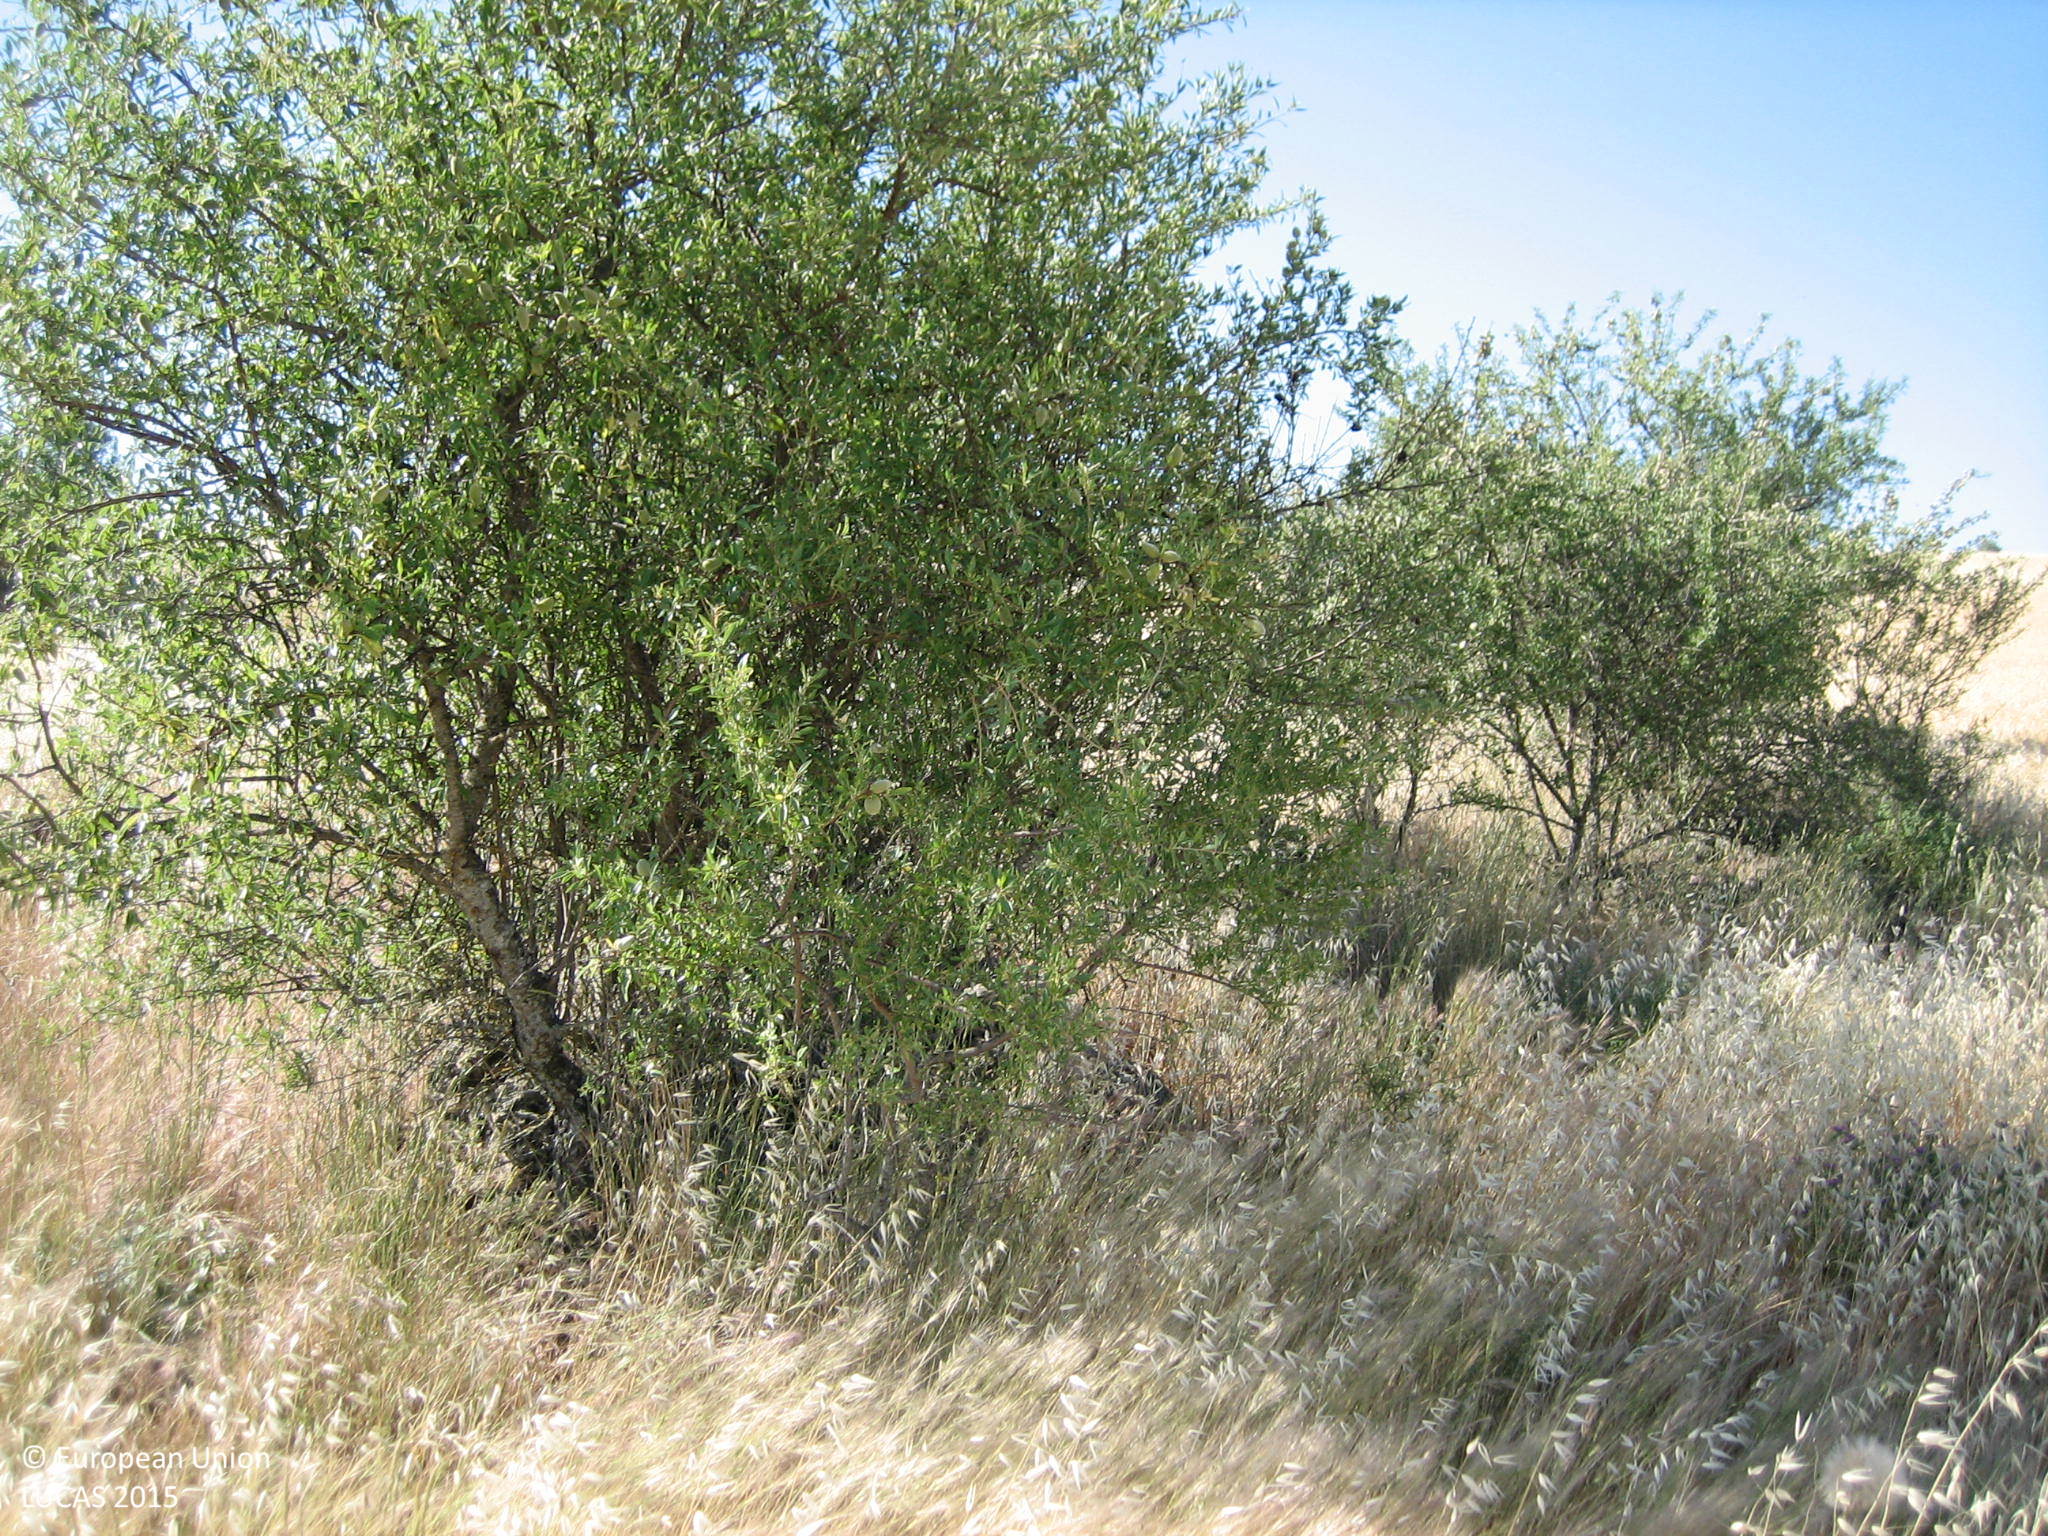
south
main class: Grassland
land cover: Spontaneously vegetated surfaces
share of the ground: > 75 %
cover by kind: herbaceous plants 95 %, shrubs 5 %
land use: Semi-natural and natural areas not in use
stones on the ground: < 10 %
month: May
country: ES
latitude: 38.9906
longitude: -4.0729
